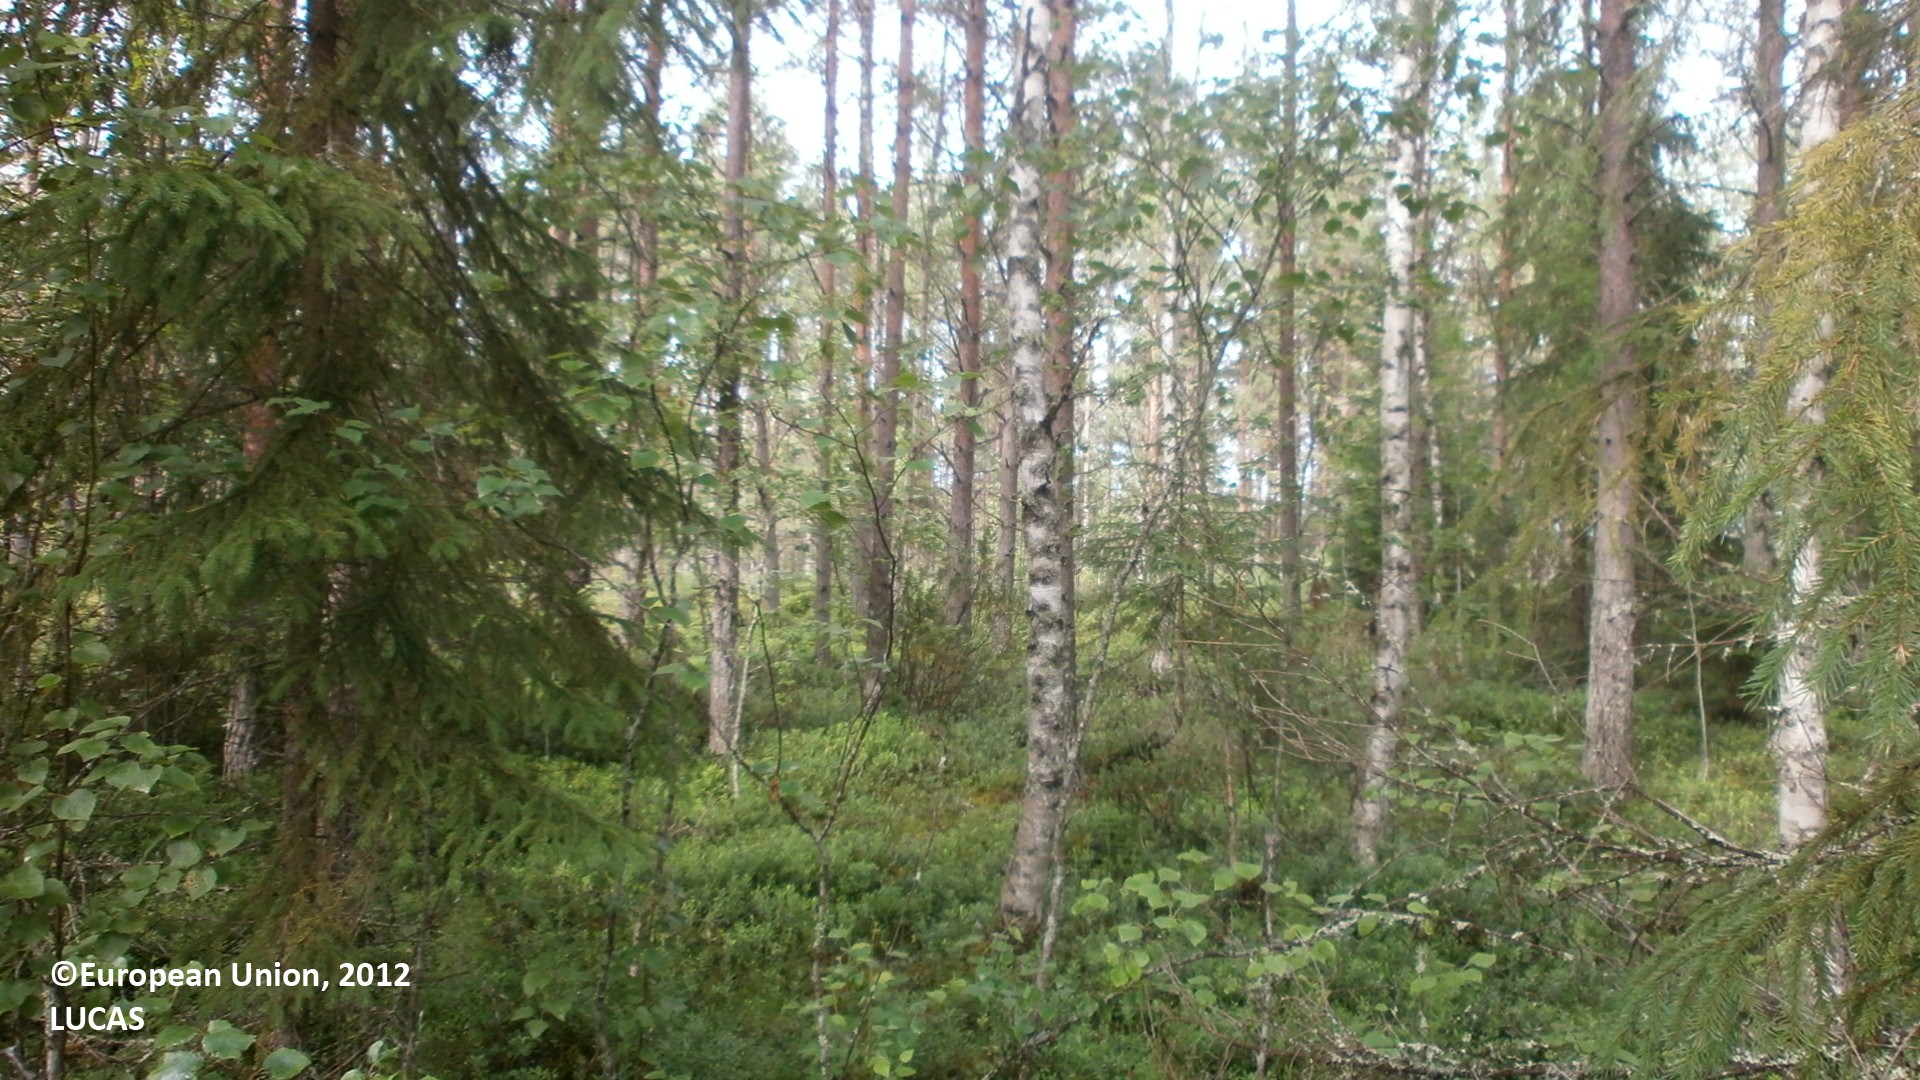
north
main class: Woodland
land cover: Pine dominated coniferous woodland
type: boreal forest
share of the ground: 50 - 75 %
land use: Forestry
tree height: > 5 m
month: July
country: FI
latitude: 64.4953
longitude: 24.3665
